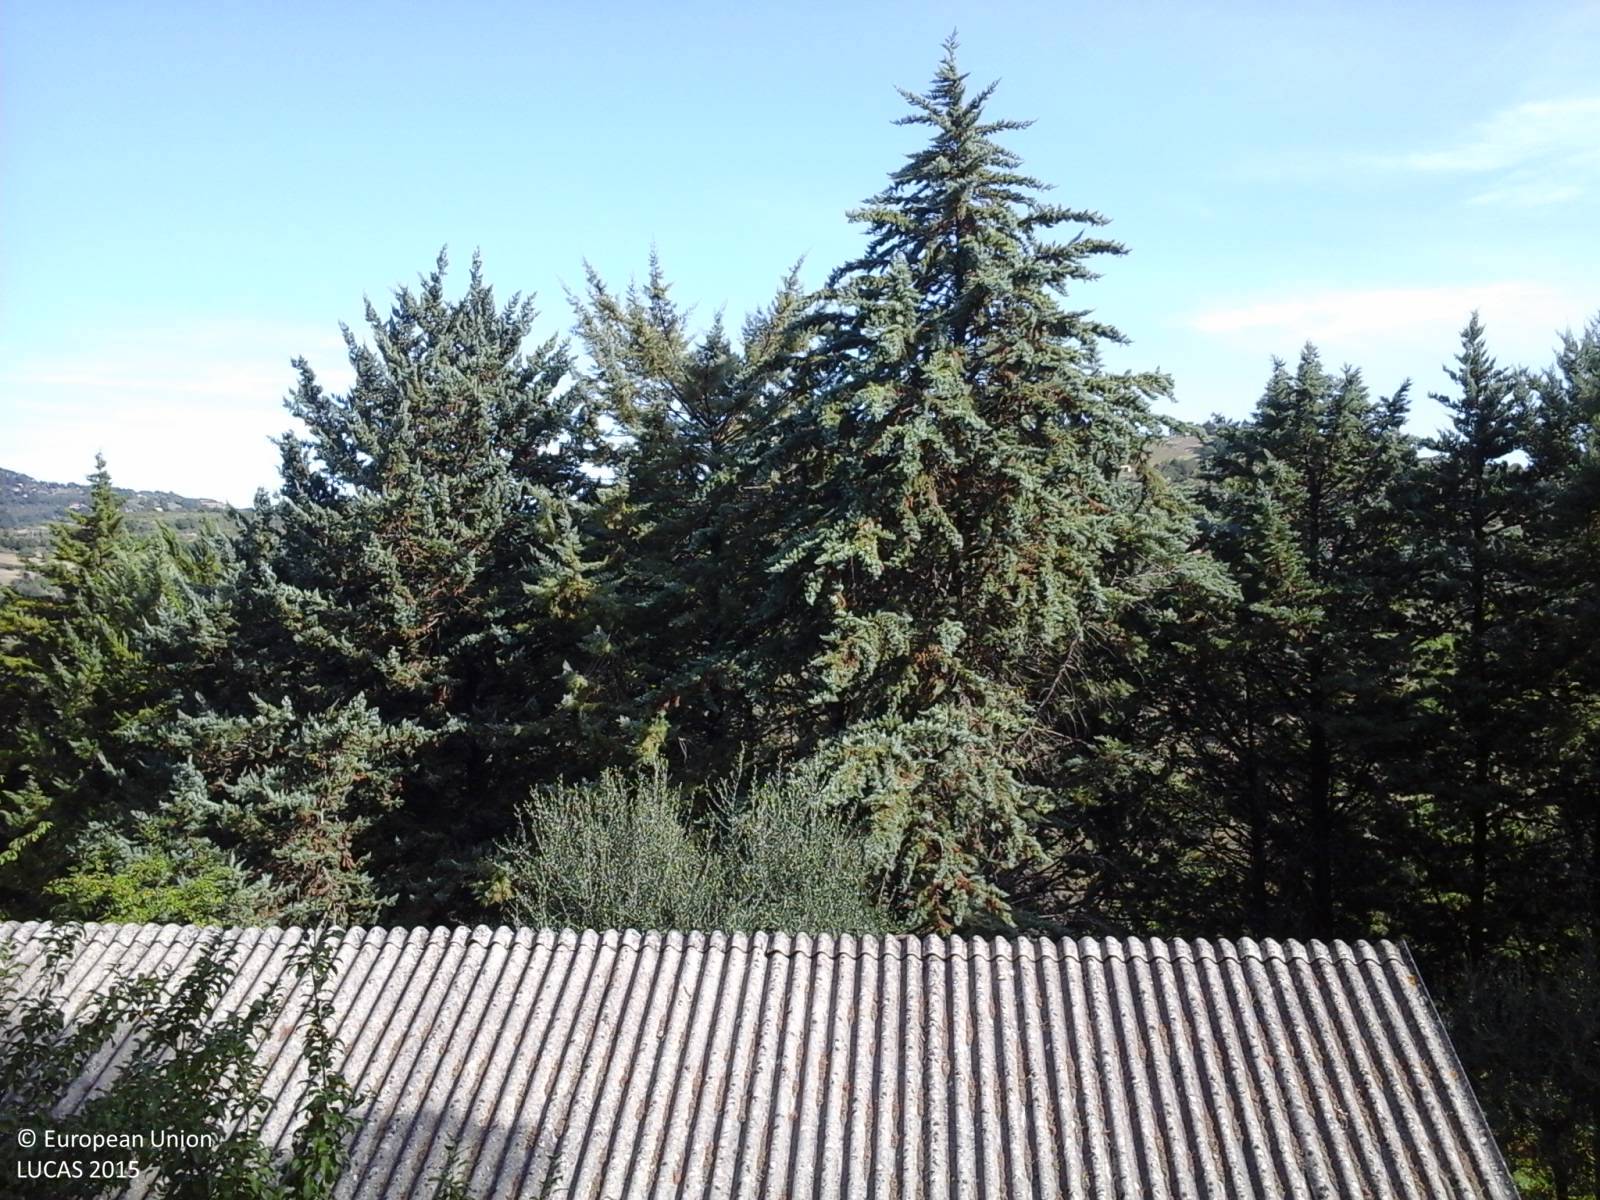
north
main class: Woodland
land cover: Other mixed woodland
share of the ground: > 75 %
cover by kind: coniferous forest trees 60 %, broadleaved forest trees 40 %
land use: Forestry
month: September
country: IT
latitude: 43.1311
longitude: 12.4147
